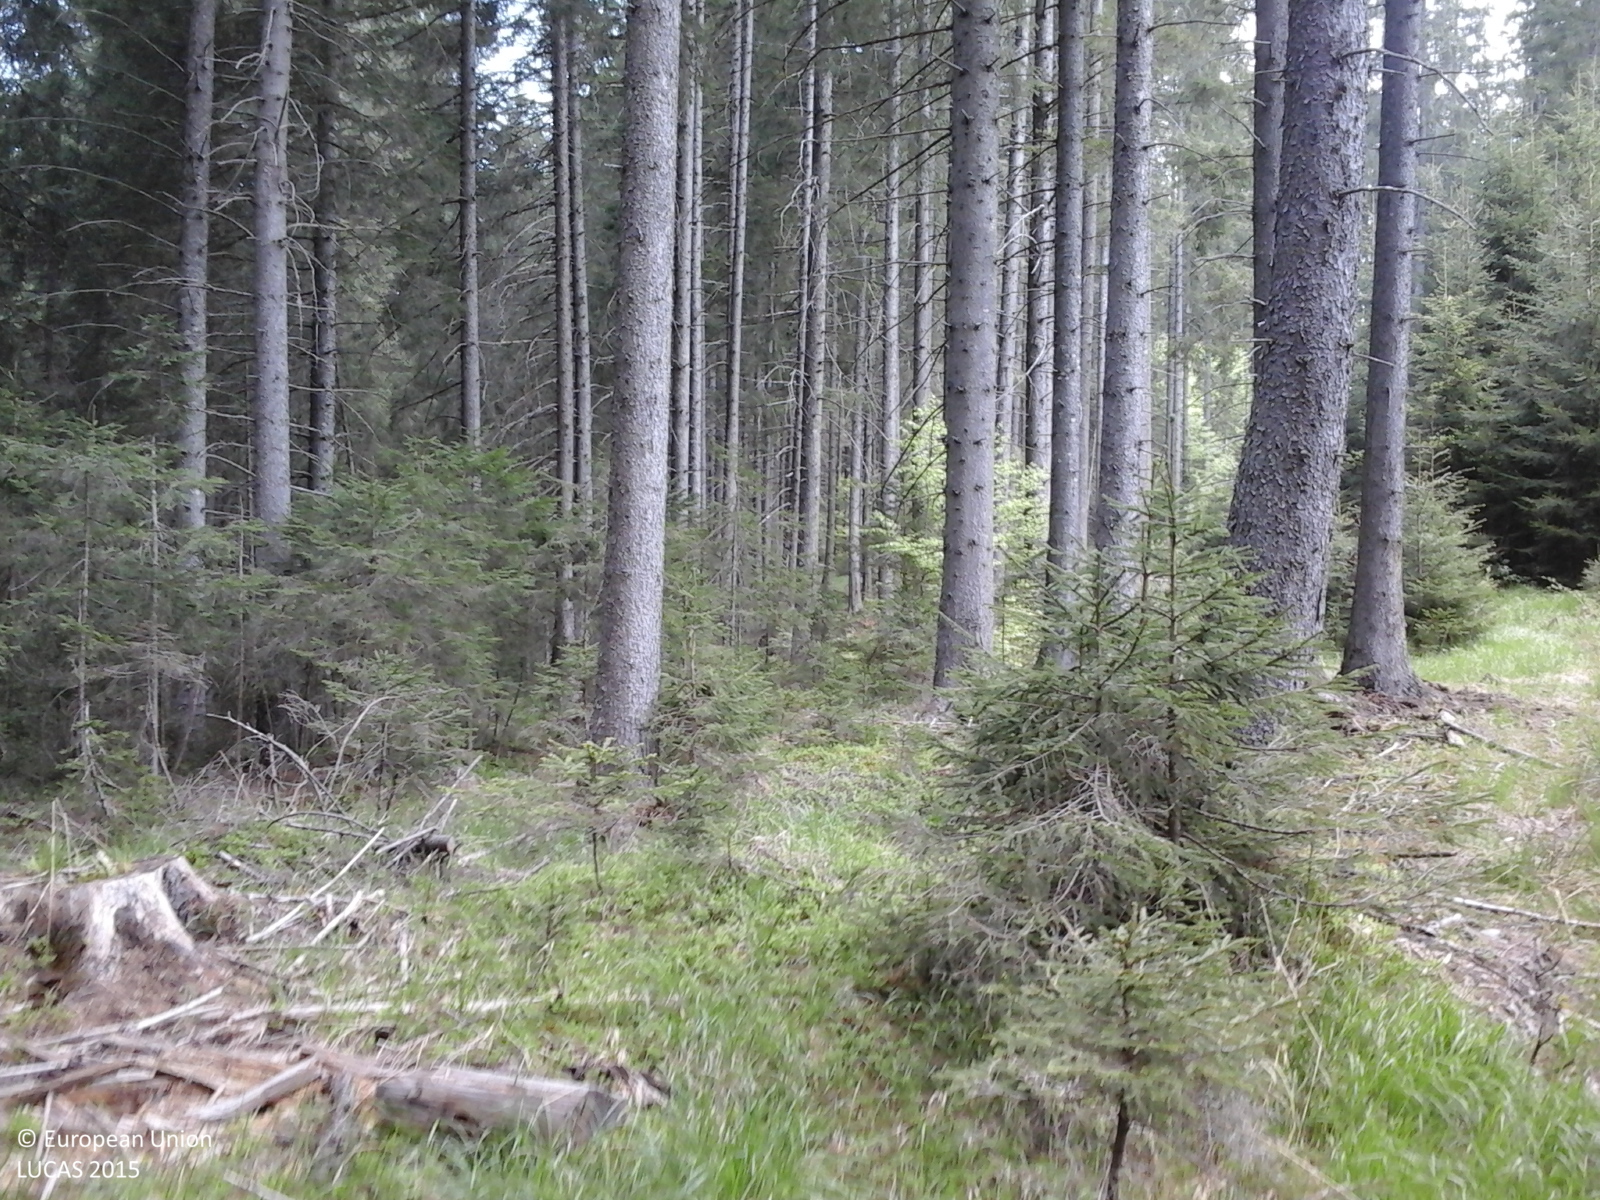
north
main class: Woodland
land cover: Spruce dominated coniferous woodland
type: alpine coniferous forest
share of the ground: > 75 %
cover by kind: coniferous forest trees 90 %, herbaceous plants 10 %
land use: Forestry
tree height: > 5 m
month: May
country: RO
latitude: 45.6703
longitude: 26.2297
